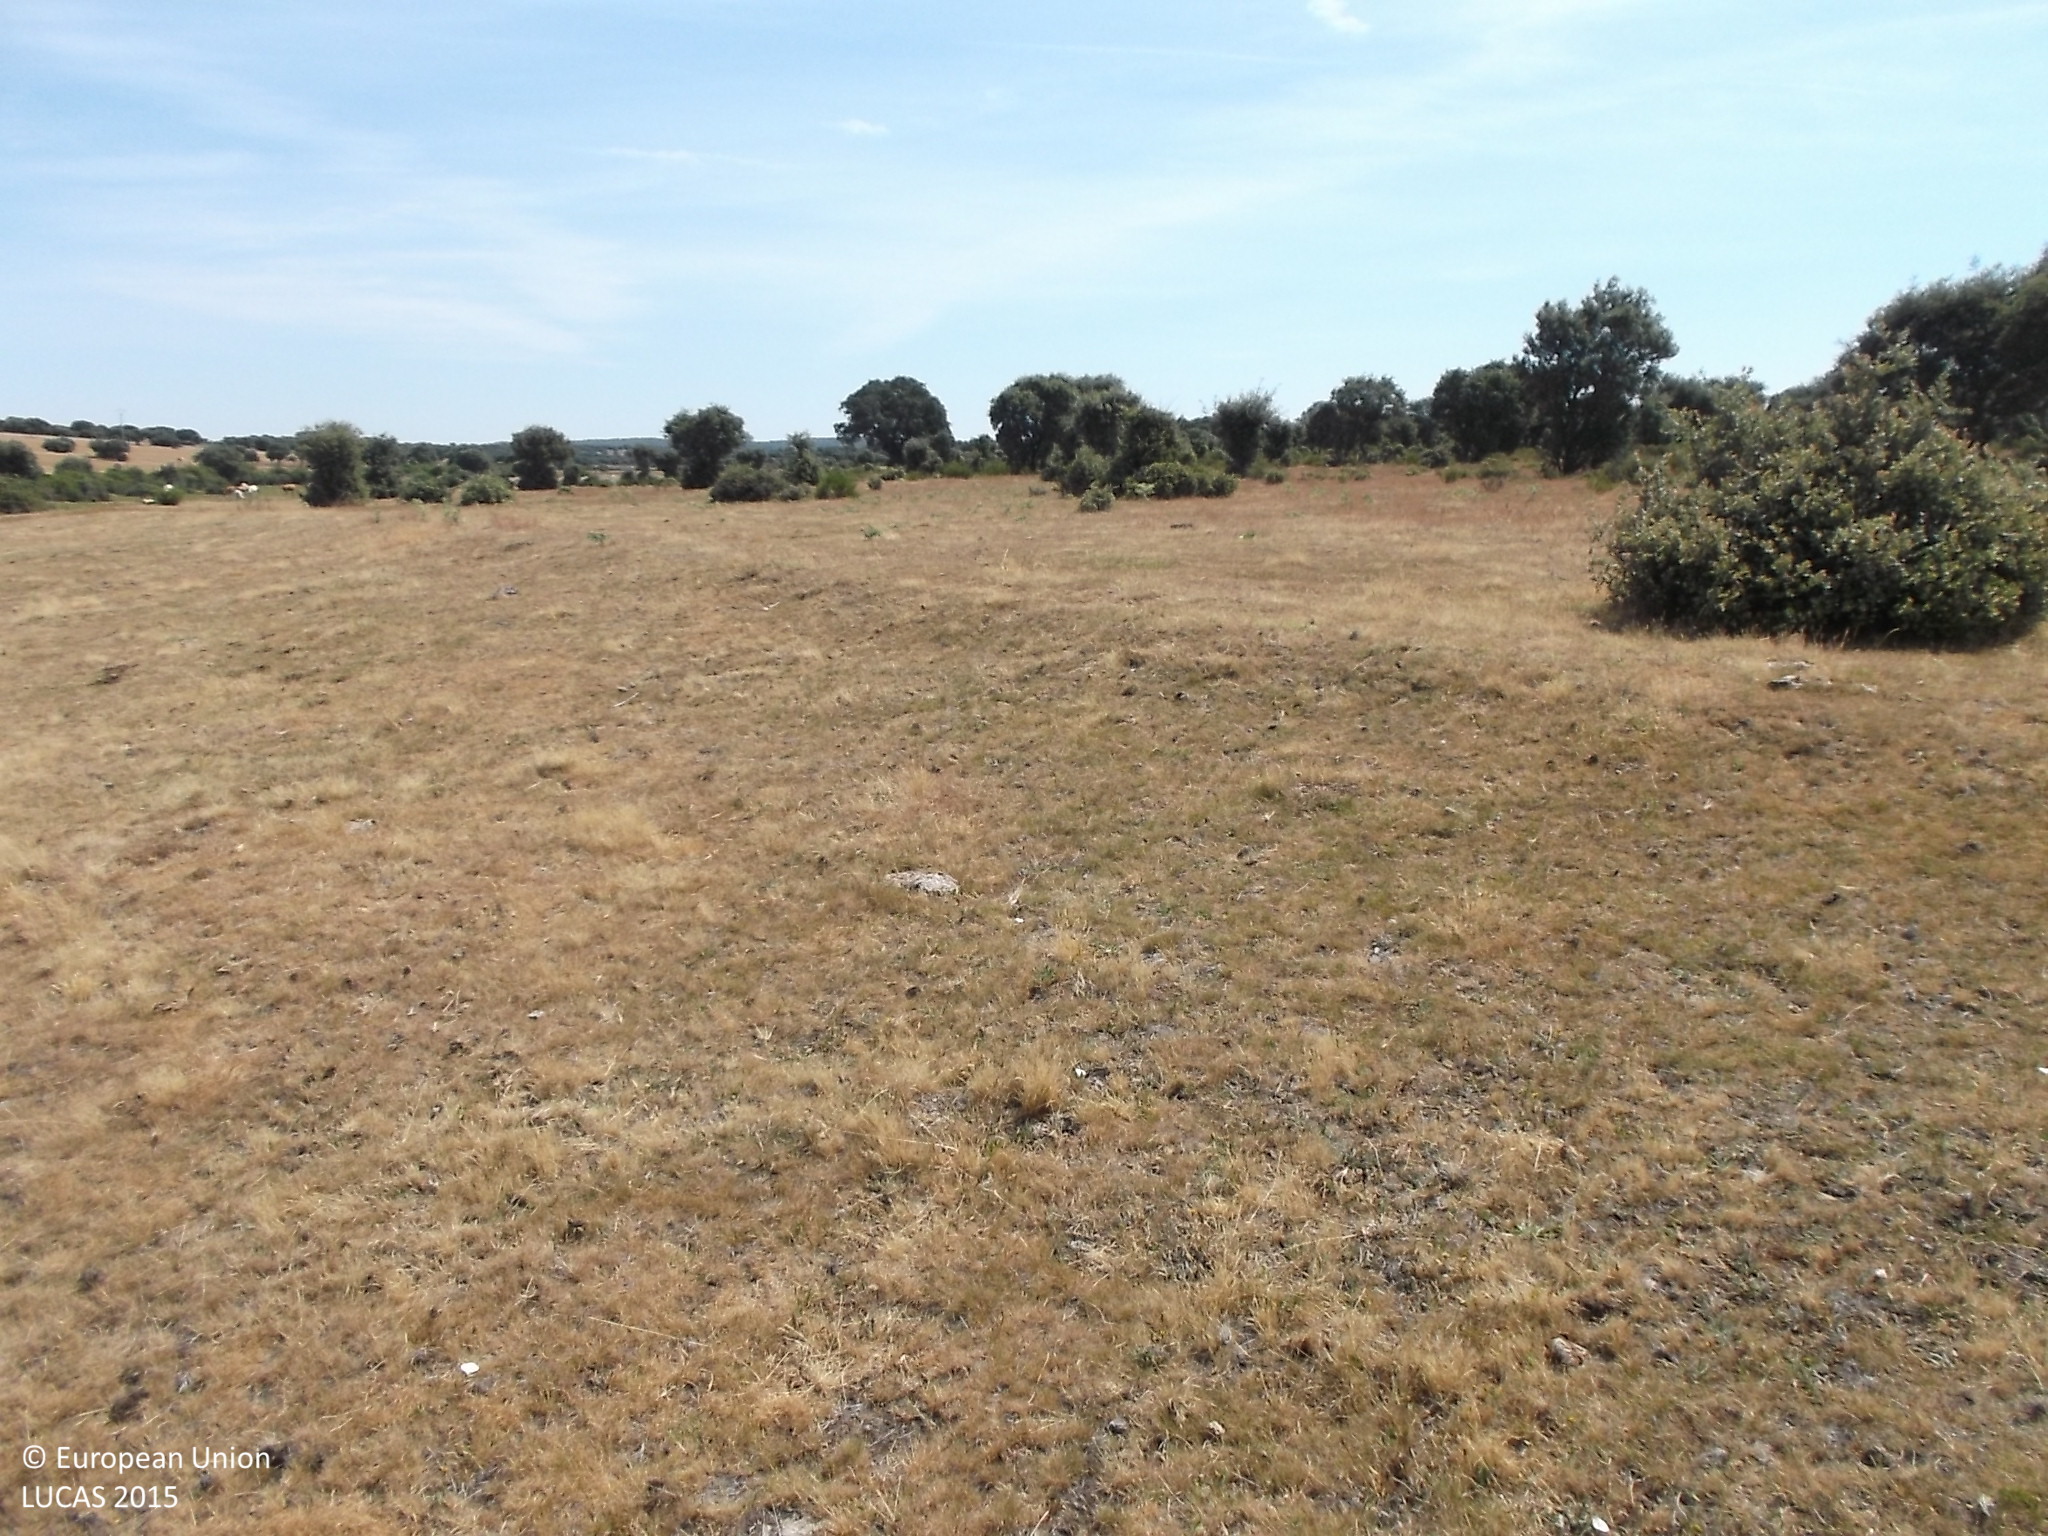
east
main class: Grassland
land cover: Grassland without tree/shrub cover
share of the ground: > 75 %
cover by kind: herbaceous plants 100 %
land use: Agriculture (excluding fallow land and kitchen gardens)
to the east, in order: Grassland without tree/shrub cover; Grassland with sparse tree/shrub cover; Shrubland with sparse tree cover
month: June
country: ES
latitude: 41.2309
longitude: -5.9663
